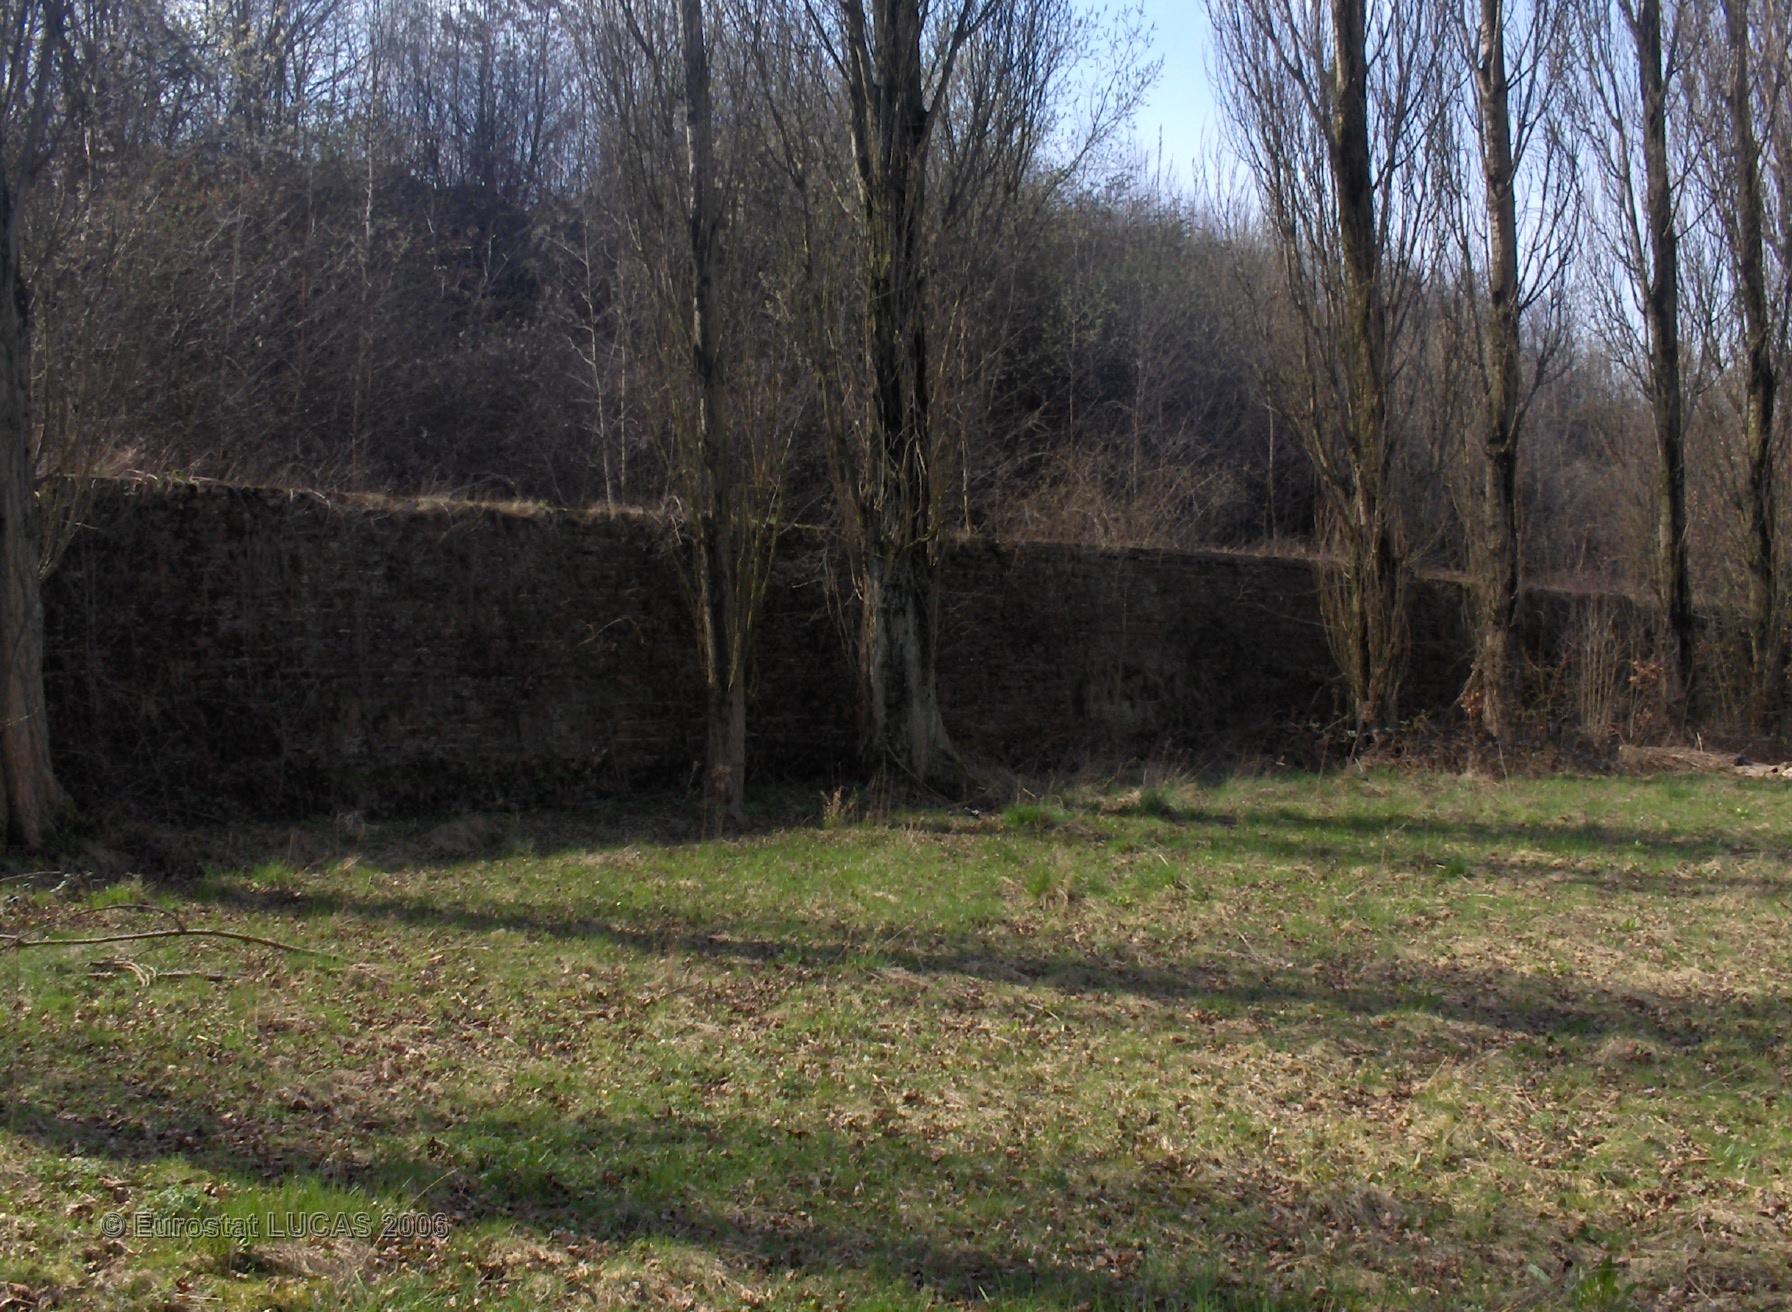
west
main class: Grassland
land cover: Grassland with sparse tree/shrub cover
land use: Agriculture (excluding fallow land and kitchen gardens)
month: April
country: BE
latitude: 50.4144
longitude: 4.5498
